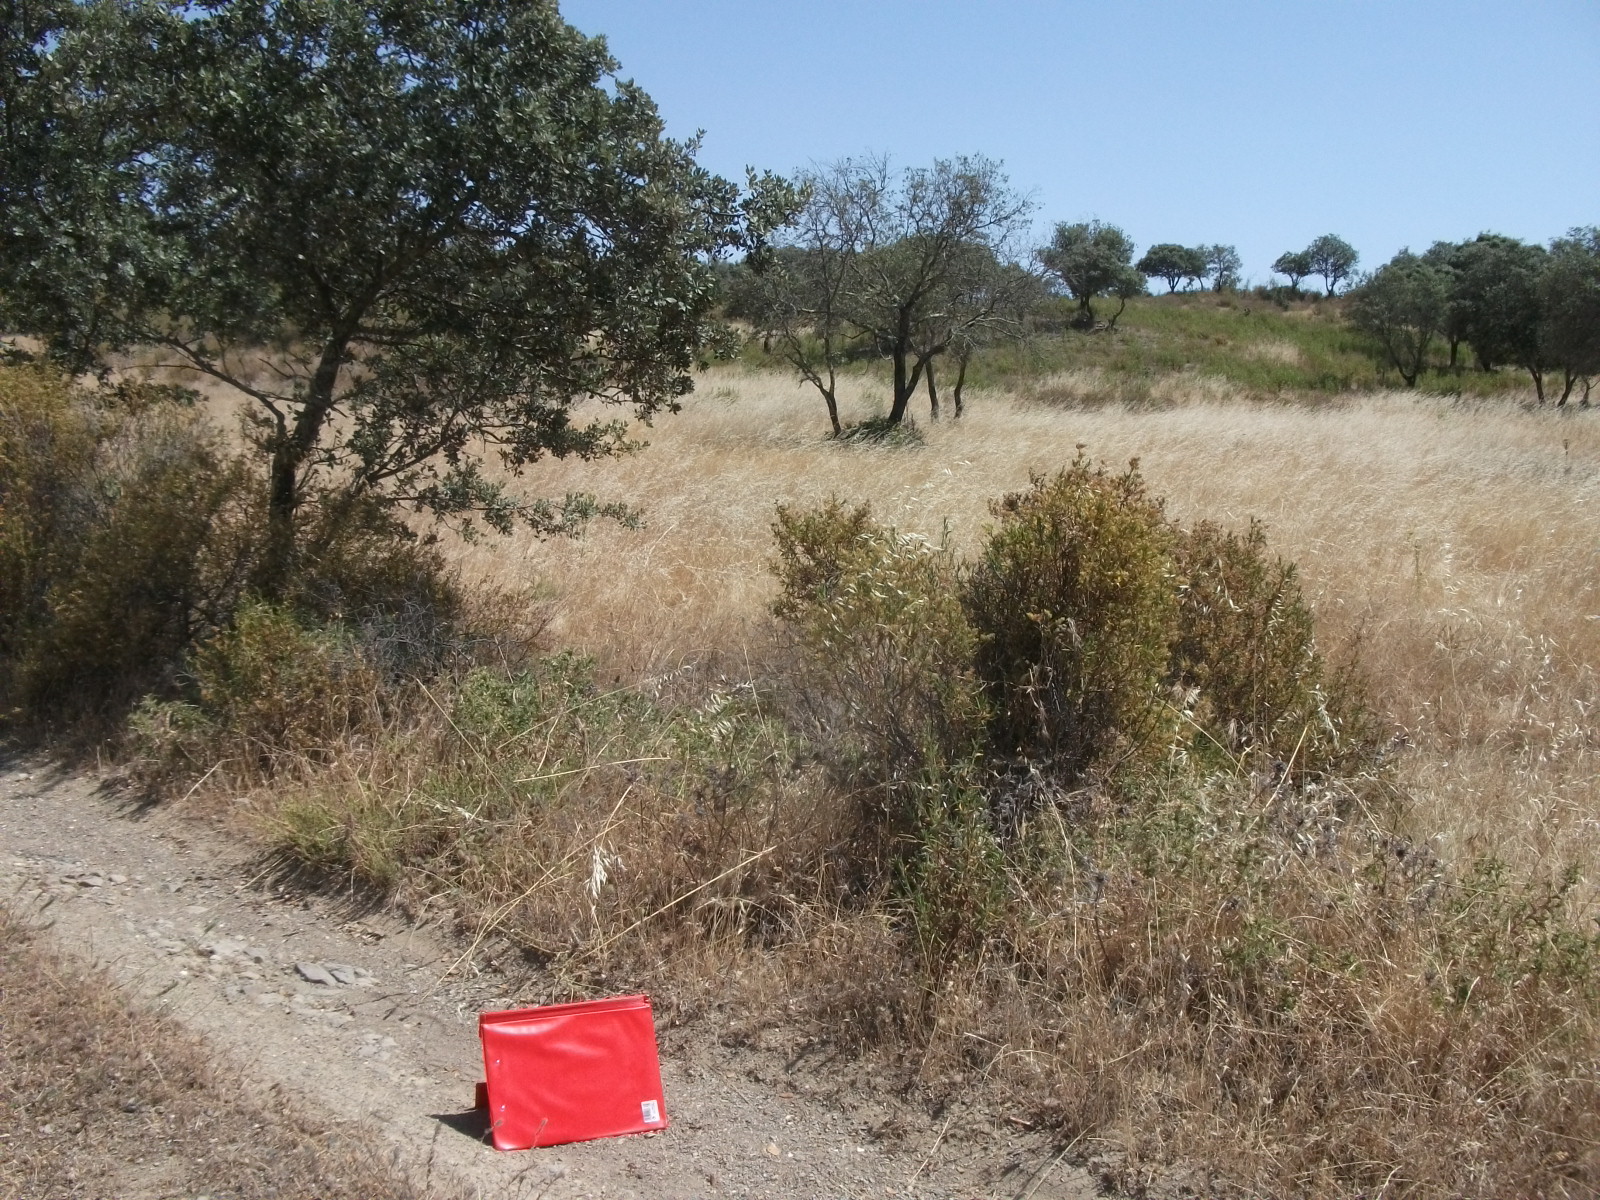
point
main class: Grassland
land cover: Grassland without tree/shrub cover
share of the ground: > 75 %
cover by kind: herbaceous plants 95 %, shrubs 5 %
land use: Agriculture (excluding fallow land and kitchen gardens)
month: June
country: ES
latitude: 37.5237
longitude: -6.9599
